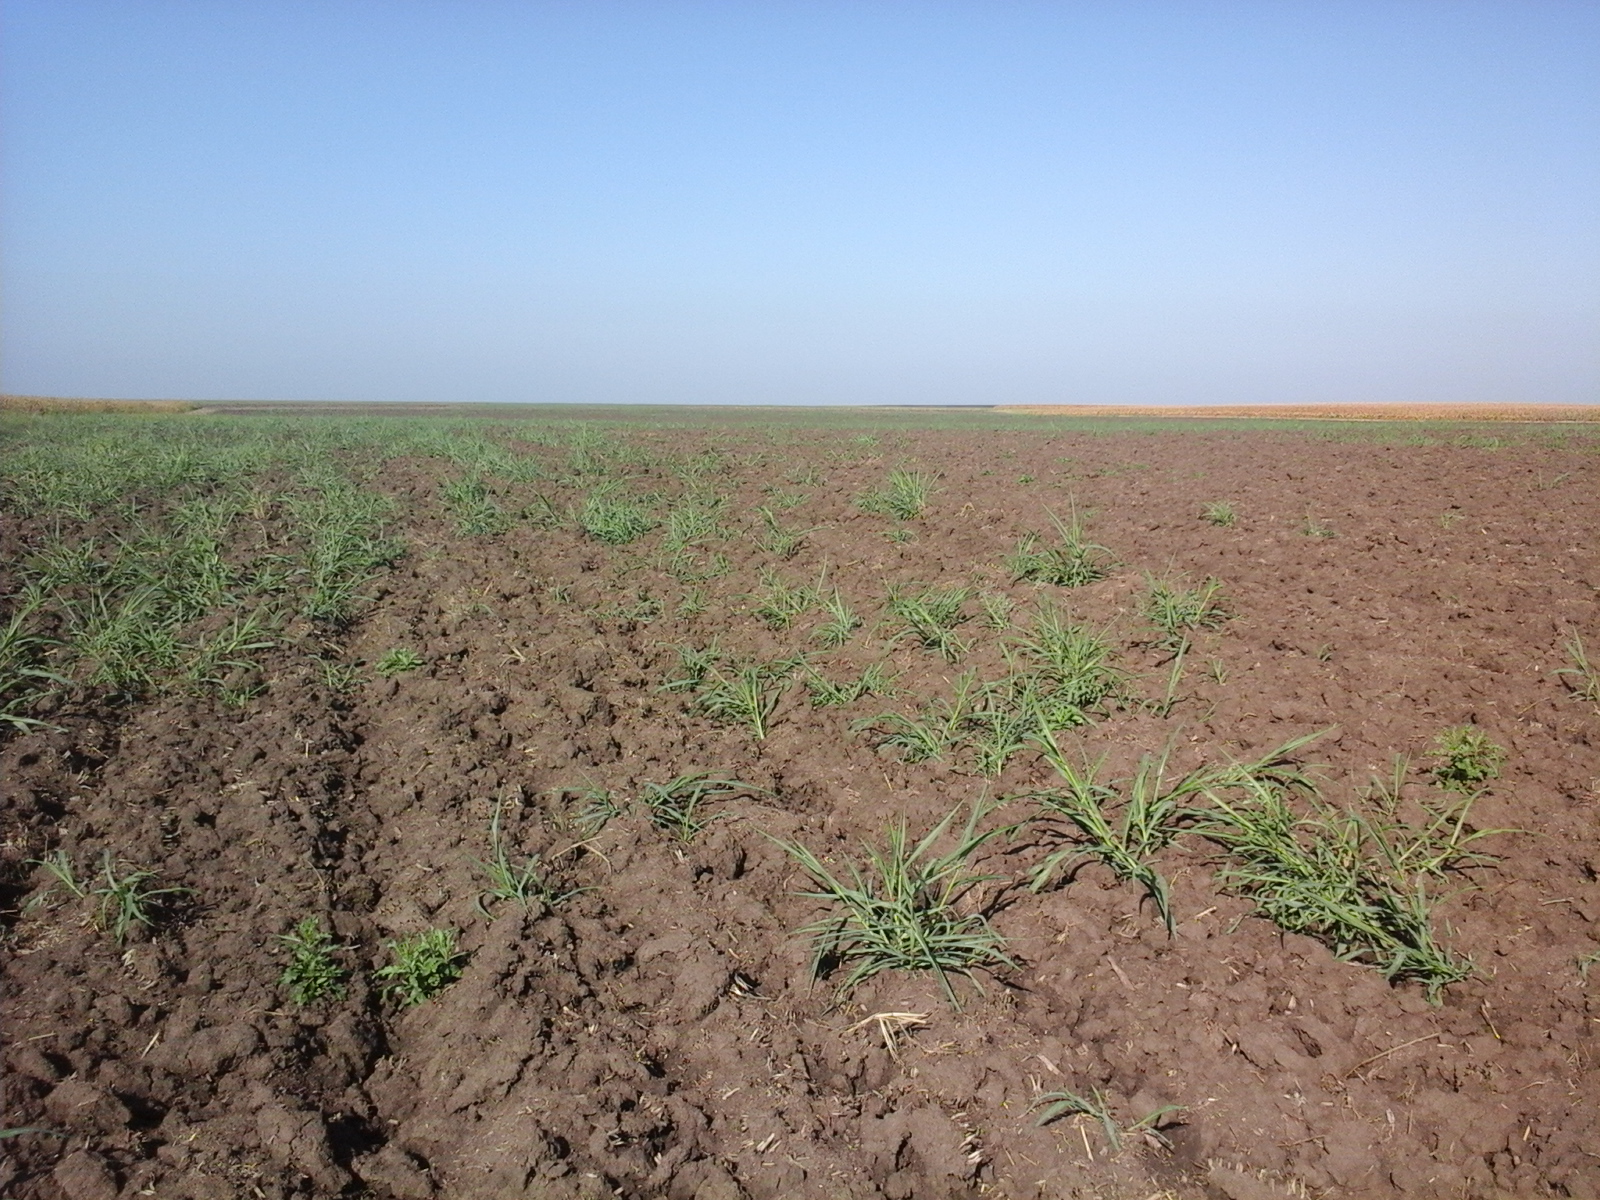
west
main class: Cropland
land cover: Common wheat
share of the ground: 10 - 25 %
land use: Agriculture (excluding fallow land and kitchen gardens)
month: August
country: RO
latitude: 46.0614
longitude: 21.1091
